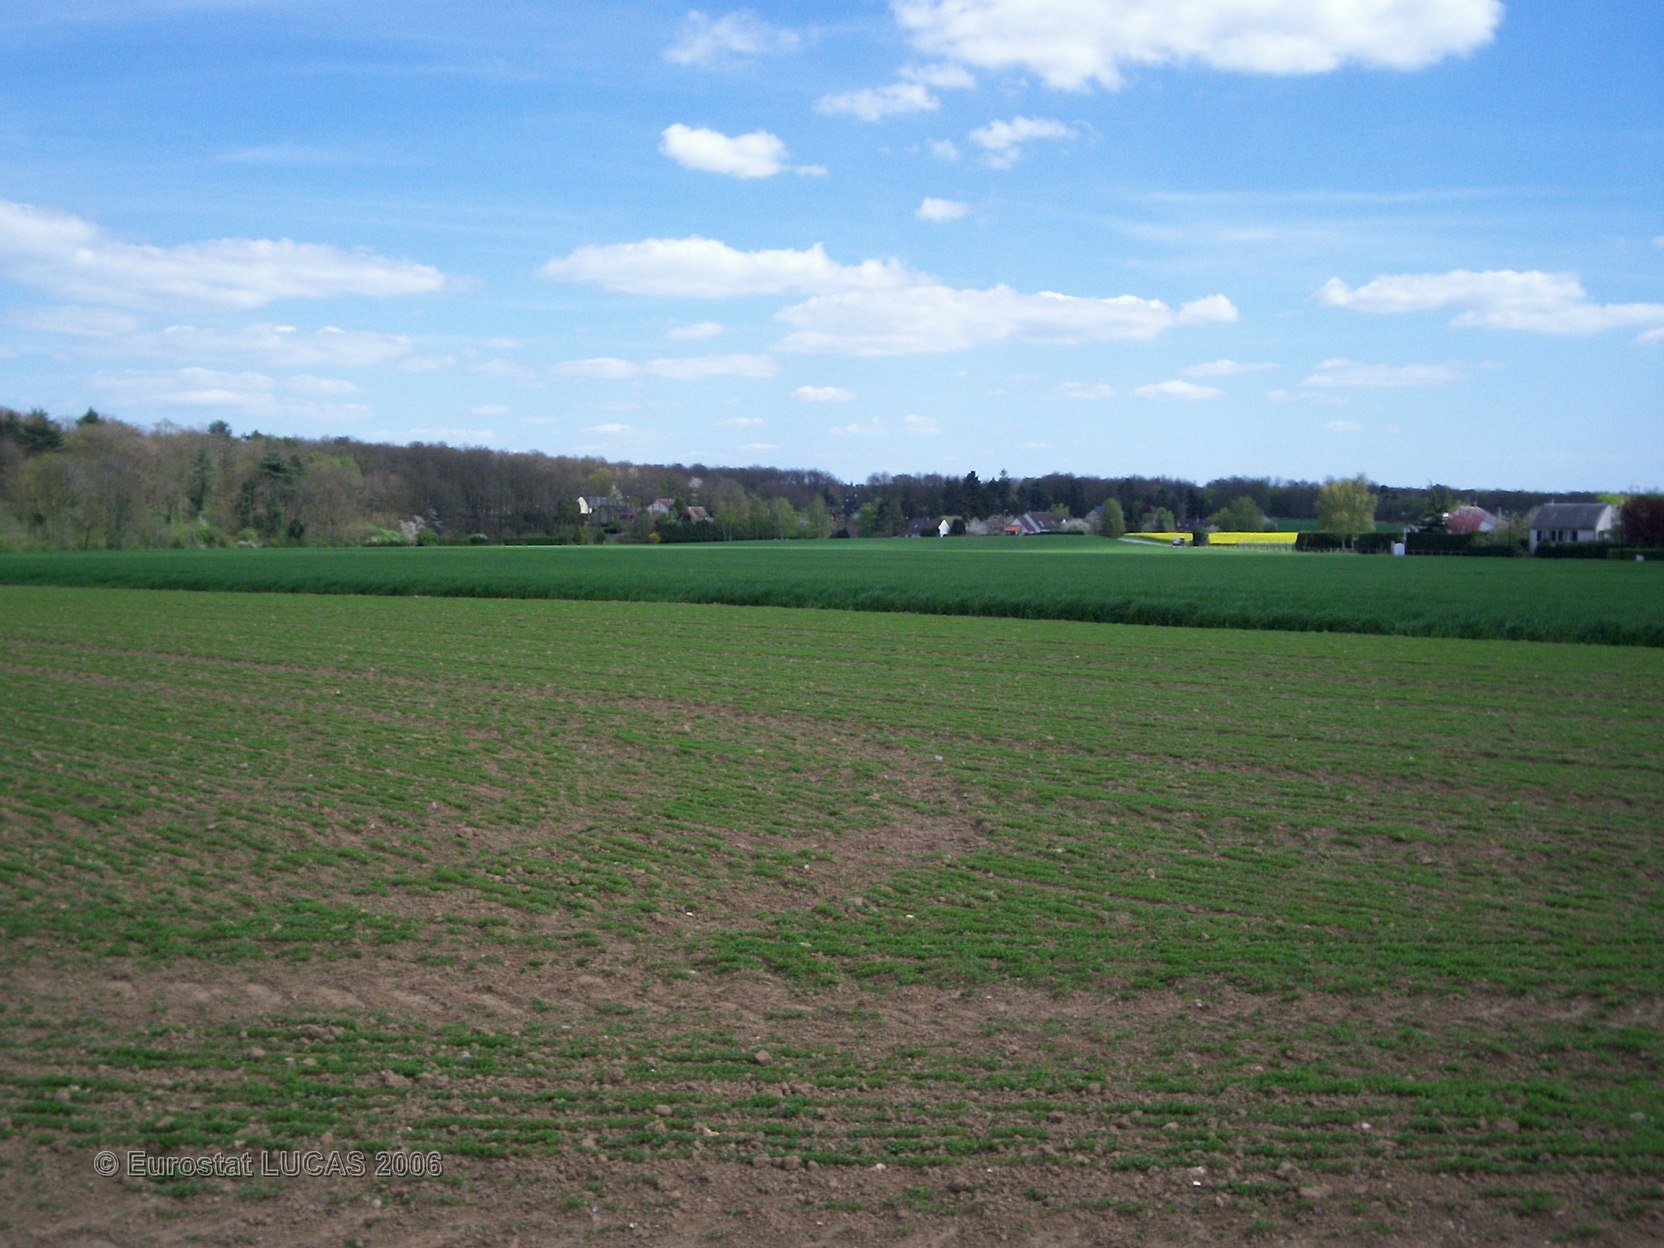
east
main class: Cropland
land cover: Other fibre and oleaginous crops
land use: Agriculture (excluding fallow land and kitchen gardens)
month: April
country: FR
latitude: 48.9482
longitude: 1.0900
